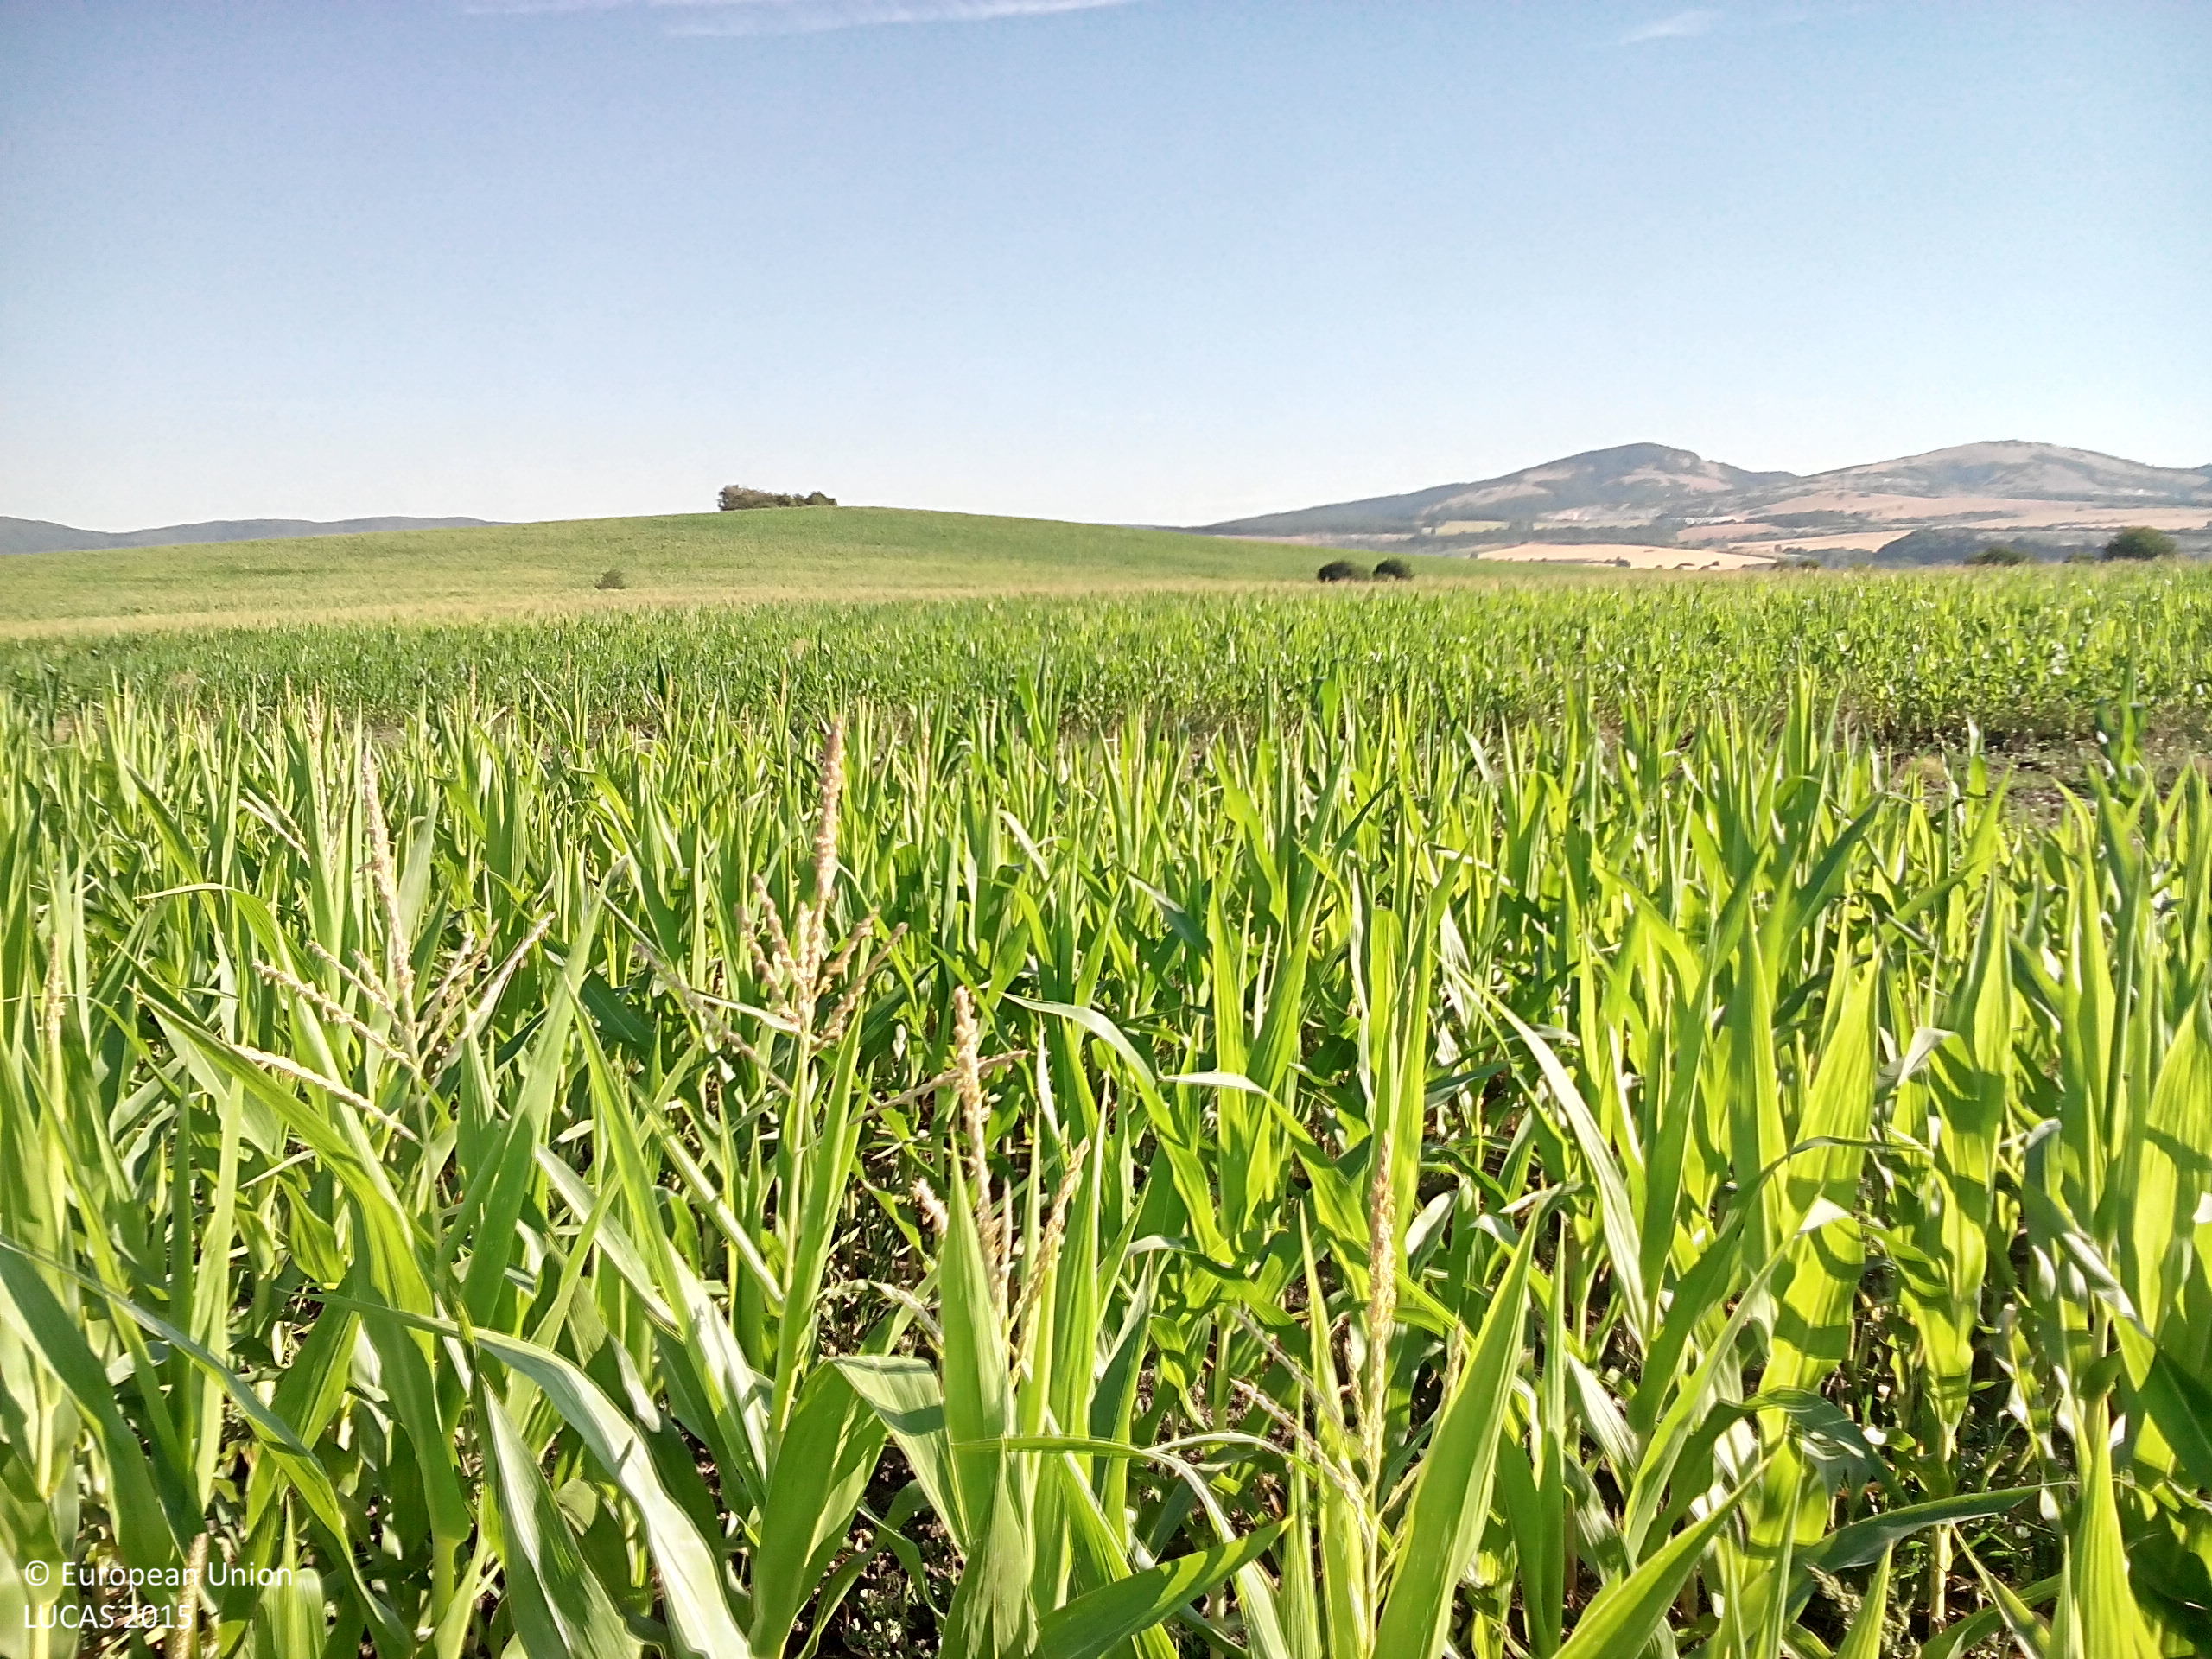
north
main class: Cropland
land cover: Maize
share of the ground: 50 - 75 %
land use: Agriculture (excluding fallow land and kitchen gardens)
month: August
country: BG
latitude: 43.1583
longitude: 23.7331
